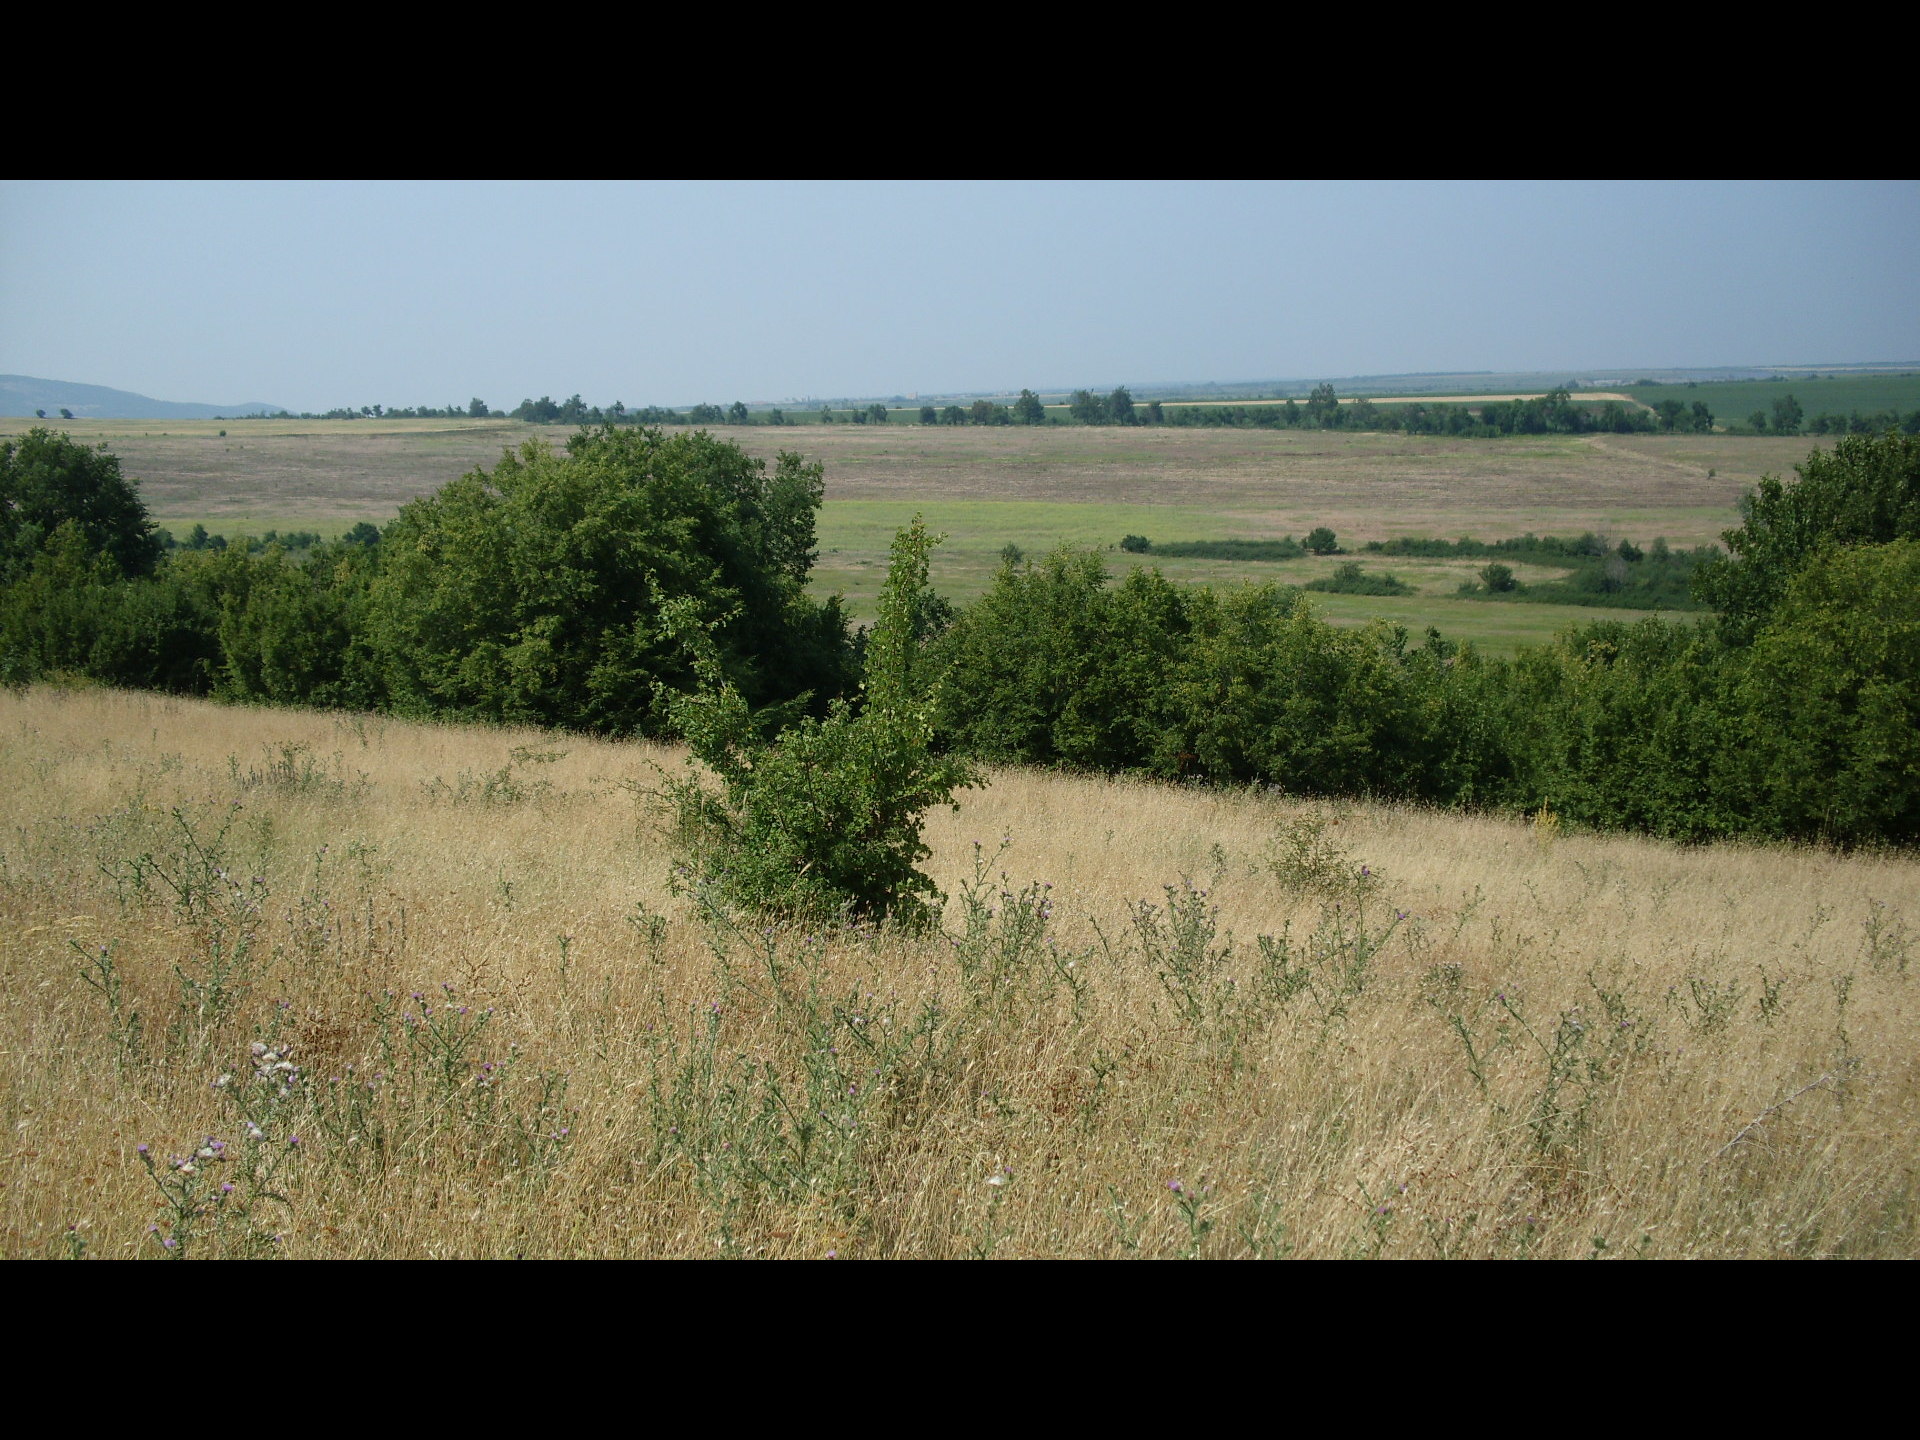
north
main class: Woodland
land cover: Broadleaved woodland
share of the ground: 25 - 50 %
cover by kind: herbaceous plants 50 %, broadleaved forest trees 25 %, shrubs 25 %
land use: Semi-natural and natural areas not in use
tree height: < 5 m
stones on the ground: 10 - 25 %
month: July
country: BG
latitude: 43.6139
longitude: 22.7602
